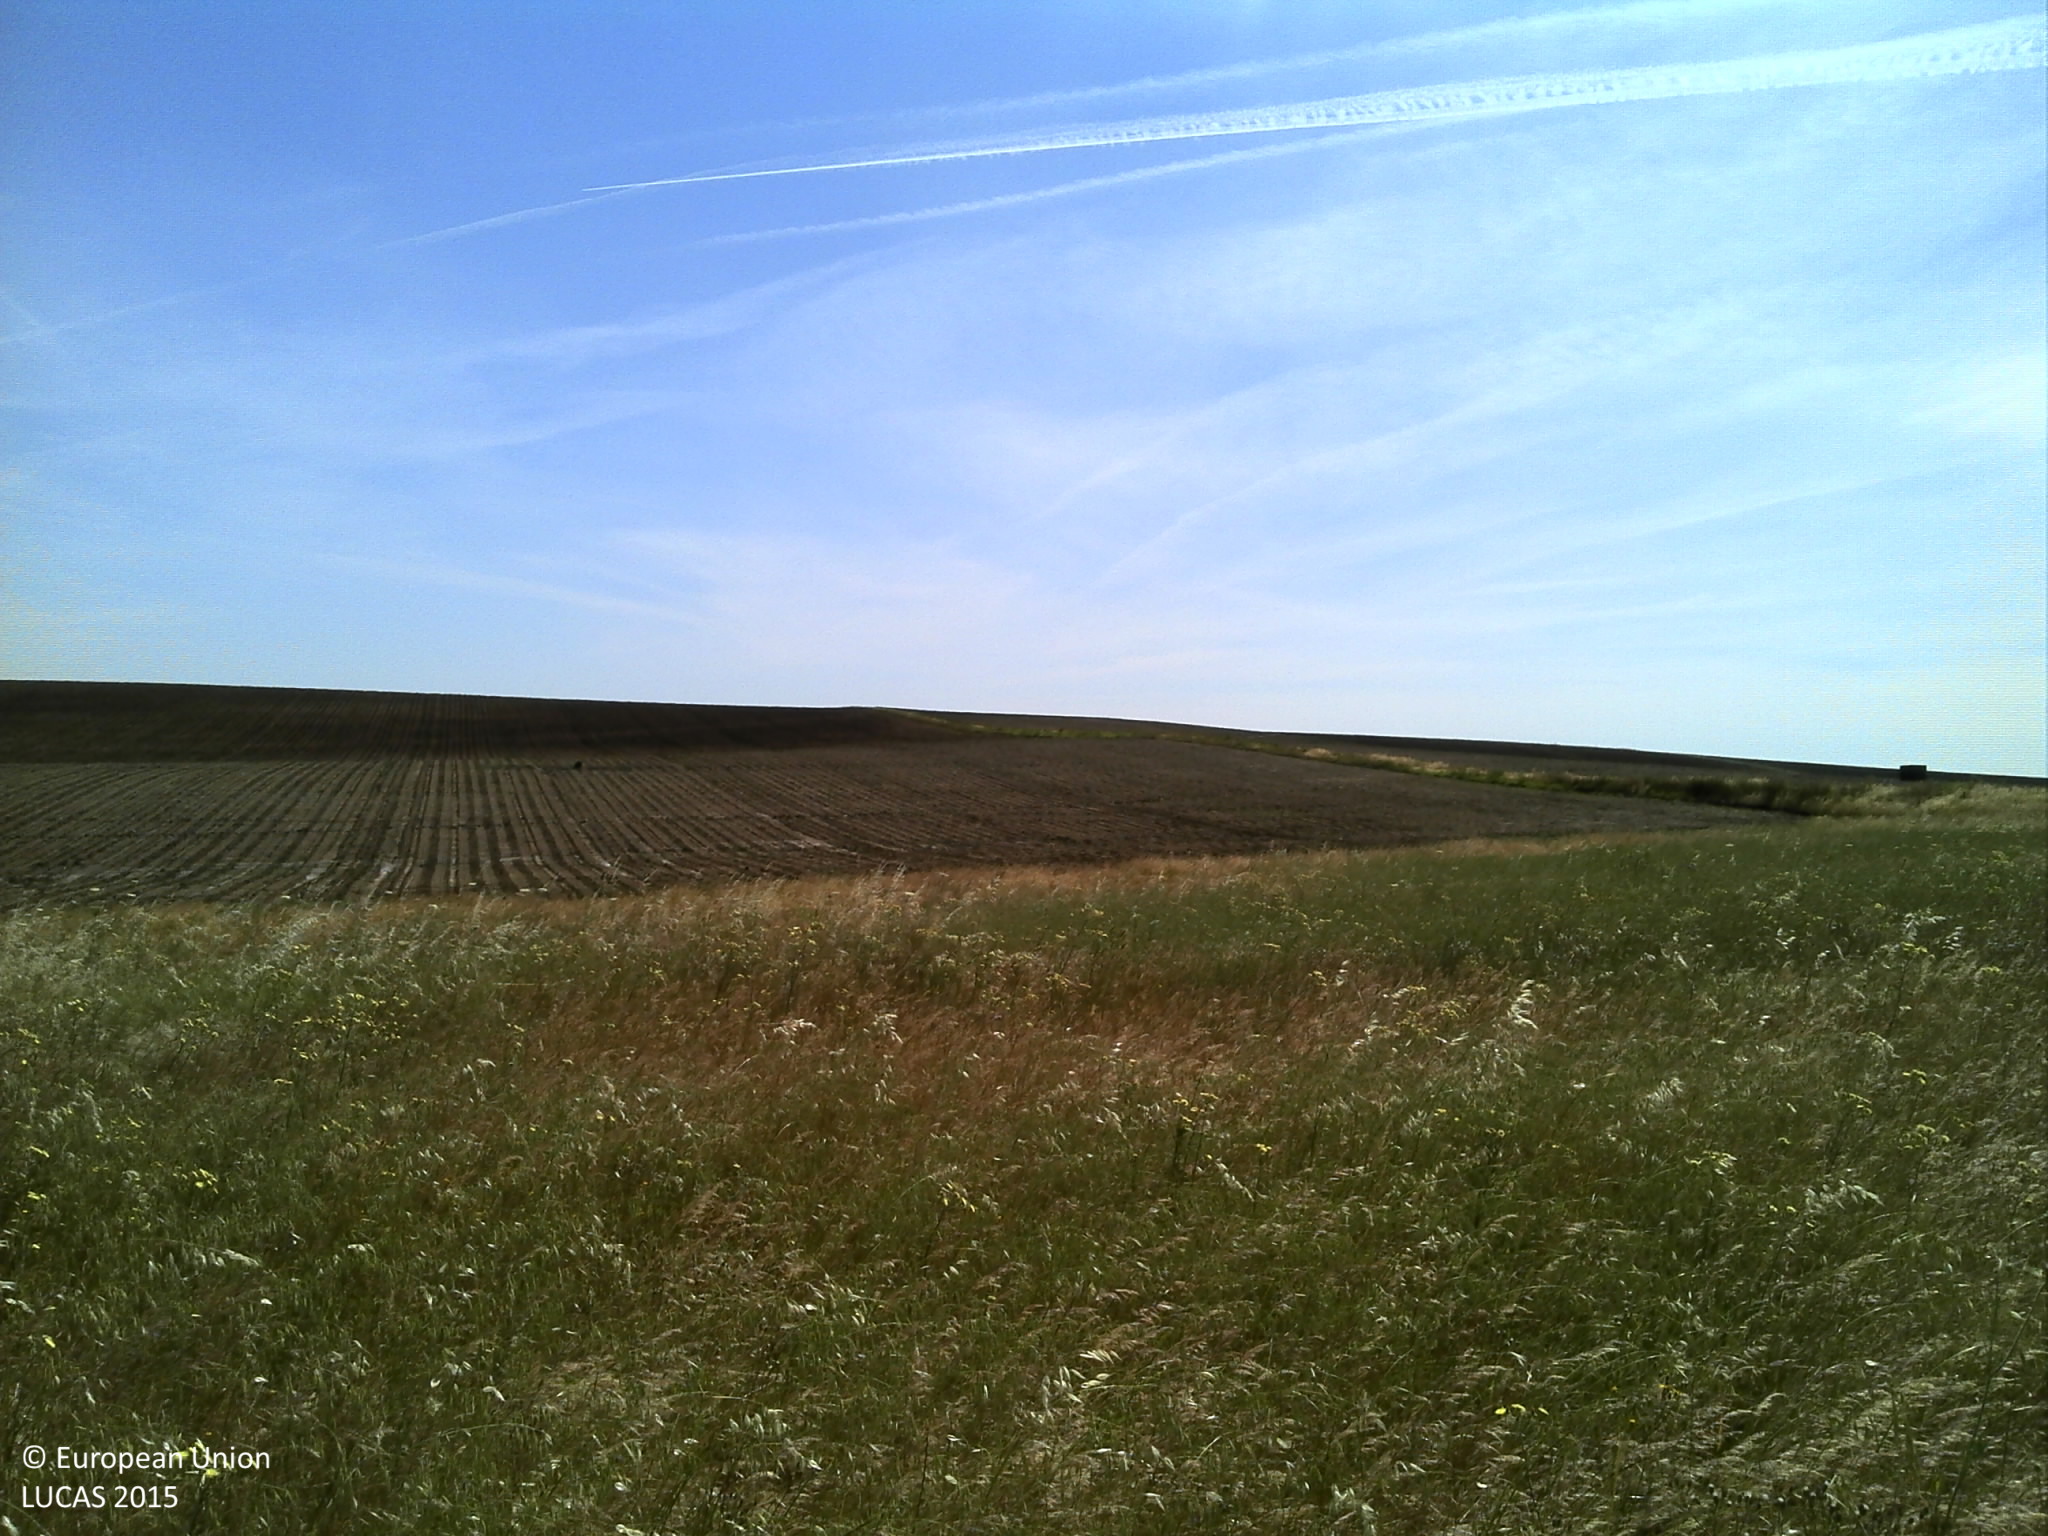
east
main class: Grassland
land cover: Grassland without tree/shrub cover
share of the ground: > 75 %
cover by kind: herbaceous plants 90 %, unconsolidated bare surface 10 %
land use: Agriculture (excluding fallow land and kitchen gardens)
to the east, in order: Grassland without tree/shrub cover; Sunflower; Grass margins; Tracks; Grass margins; Sunflower
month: May
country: PT
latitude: 39.0822
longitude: -7.6251
